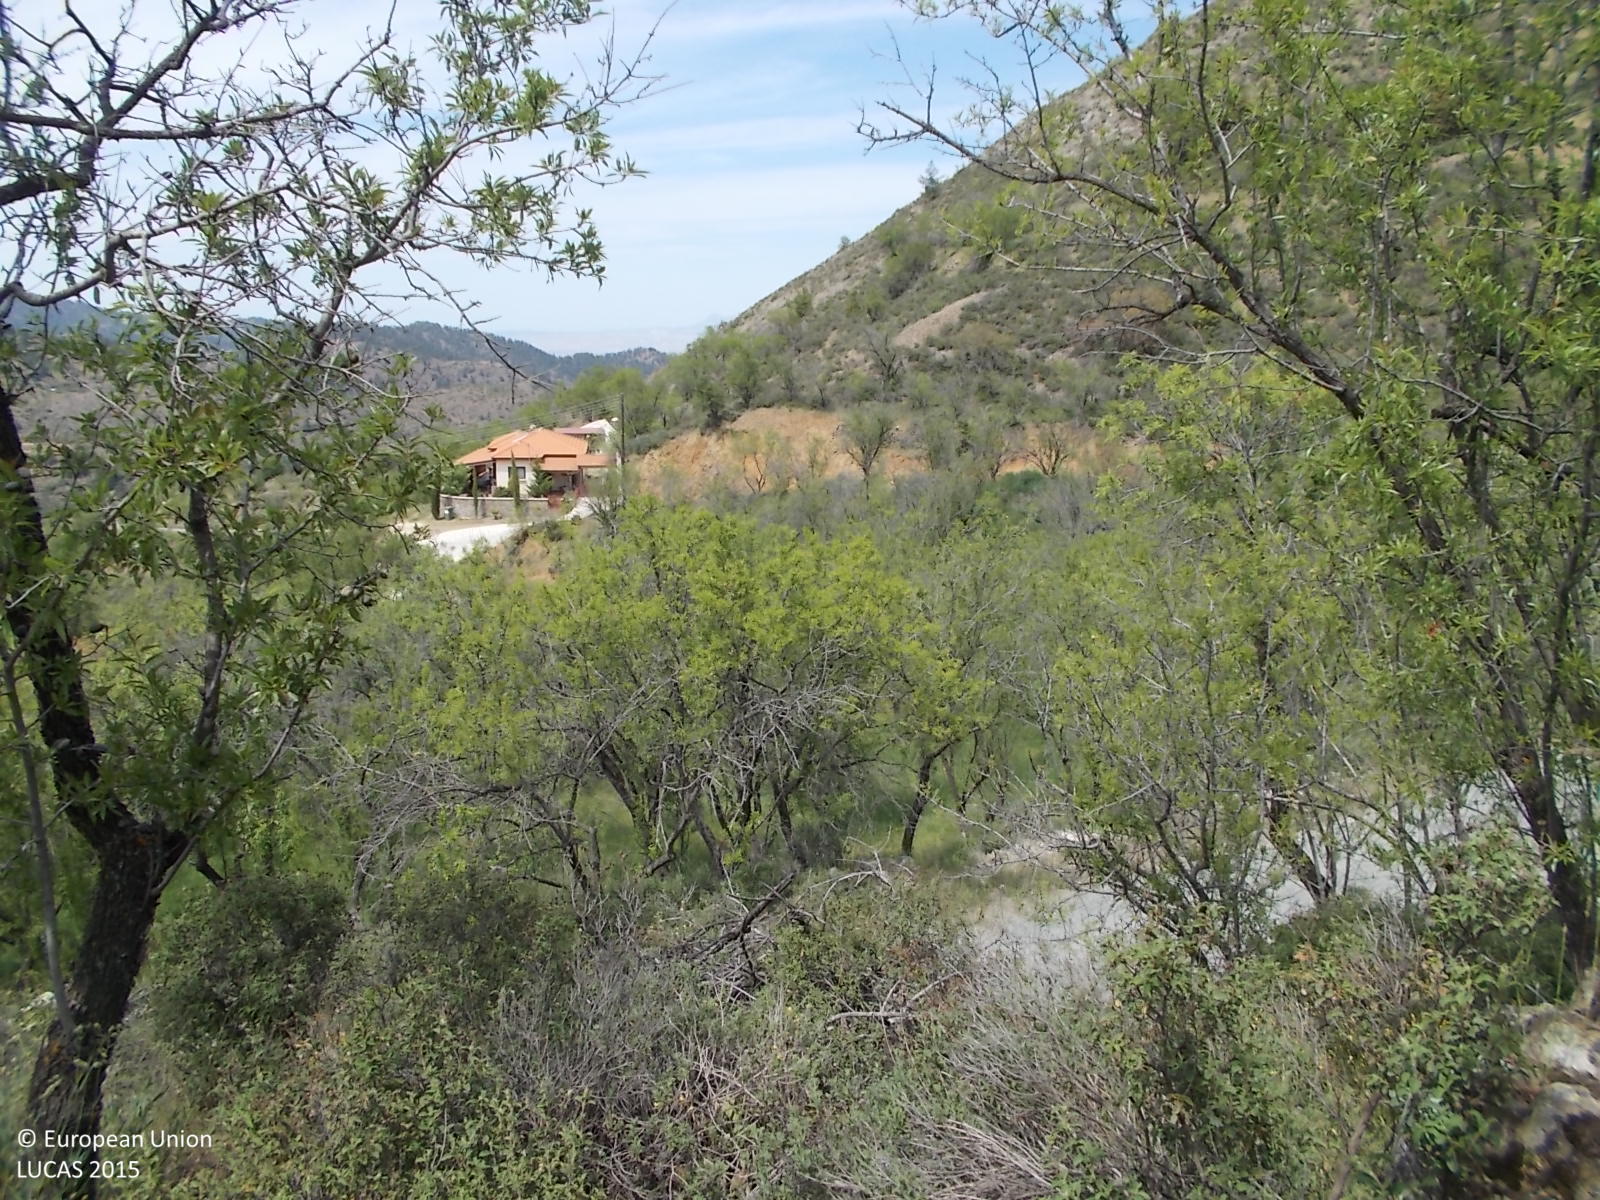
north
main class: Cropland
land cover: Nuts trees
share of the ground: > 75 %
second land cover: Grassland without tree/shrub cover
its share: > 75 %
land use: Abandoned areas
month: May
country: CY
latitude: 34.9449
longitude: 33.0700
